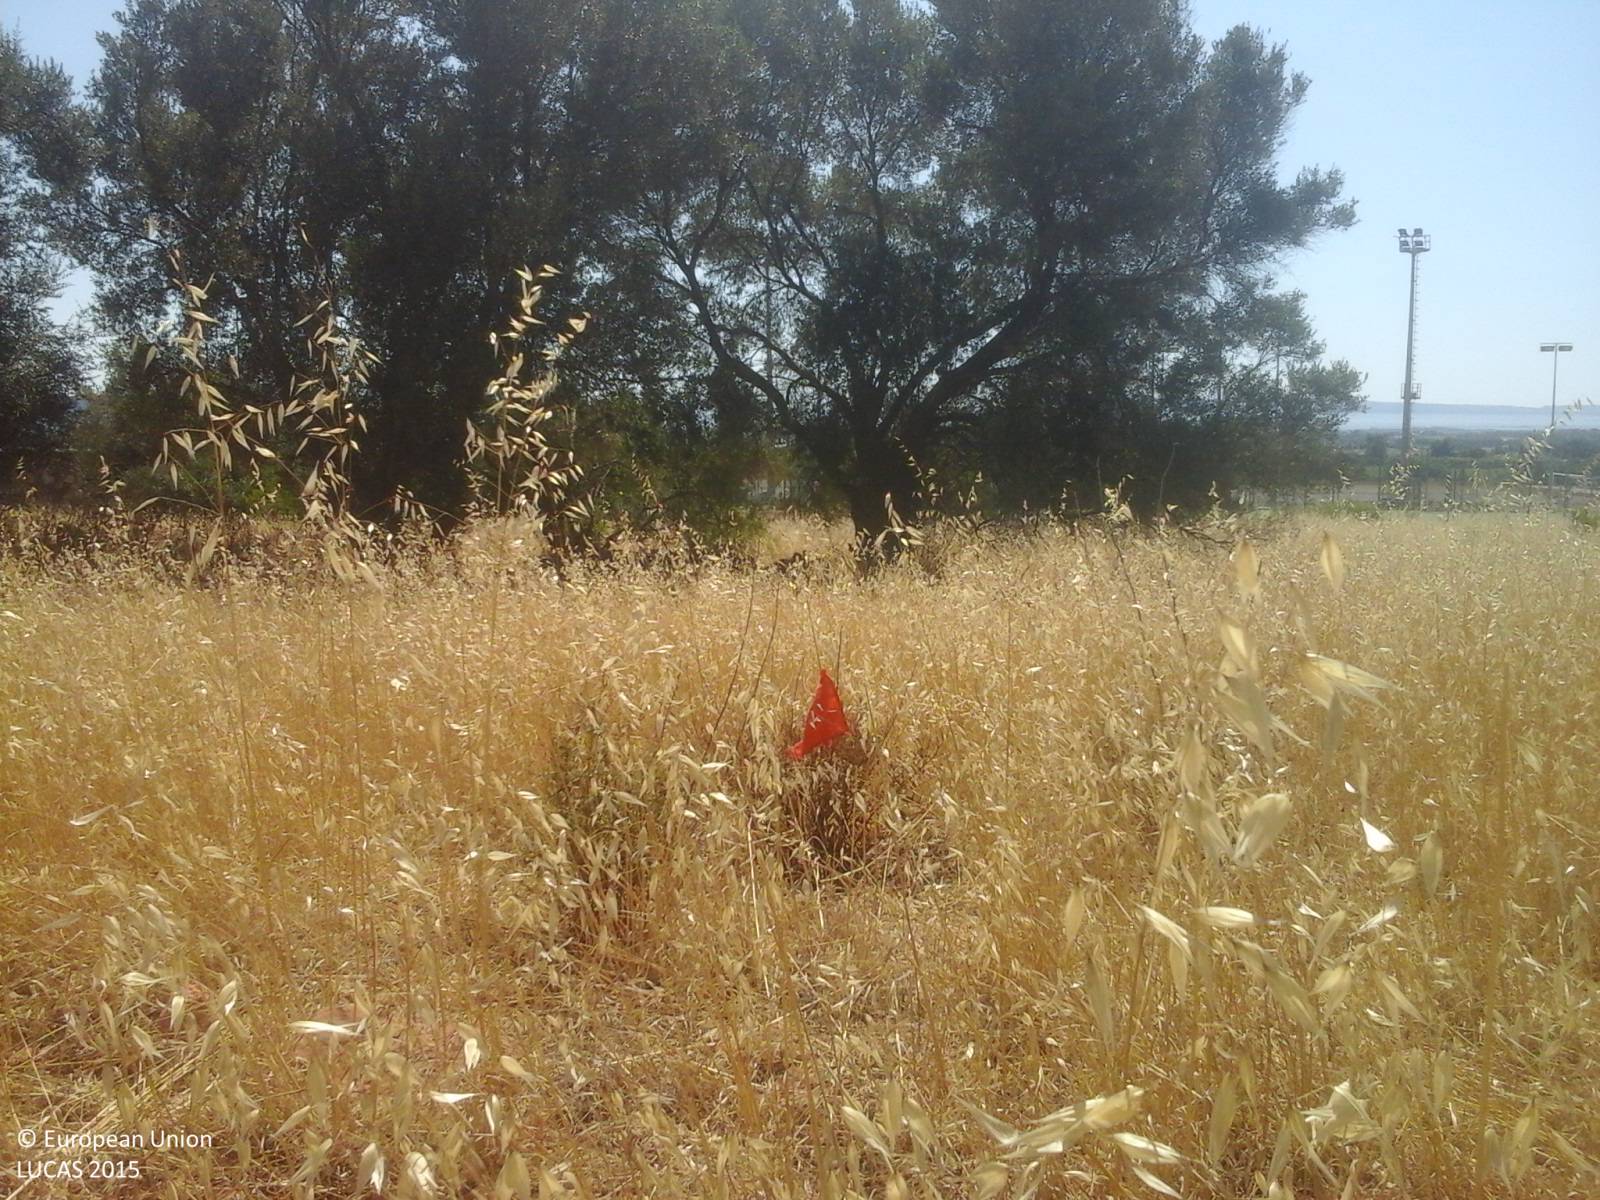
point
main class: Cropland
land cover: Oats
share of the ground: > 75 %
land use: Agriculture (excluding fallow land and kitchen gardens)
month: June
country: IT
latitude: 39.0440
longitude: 8.6338
